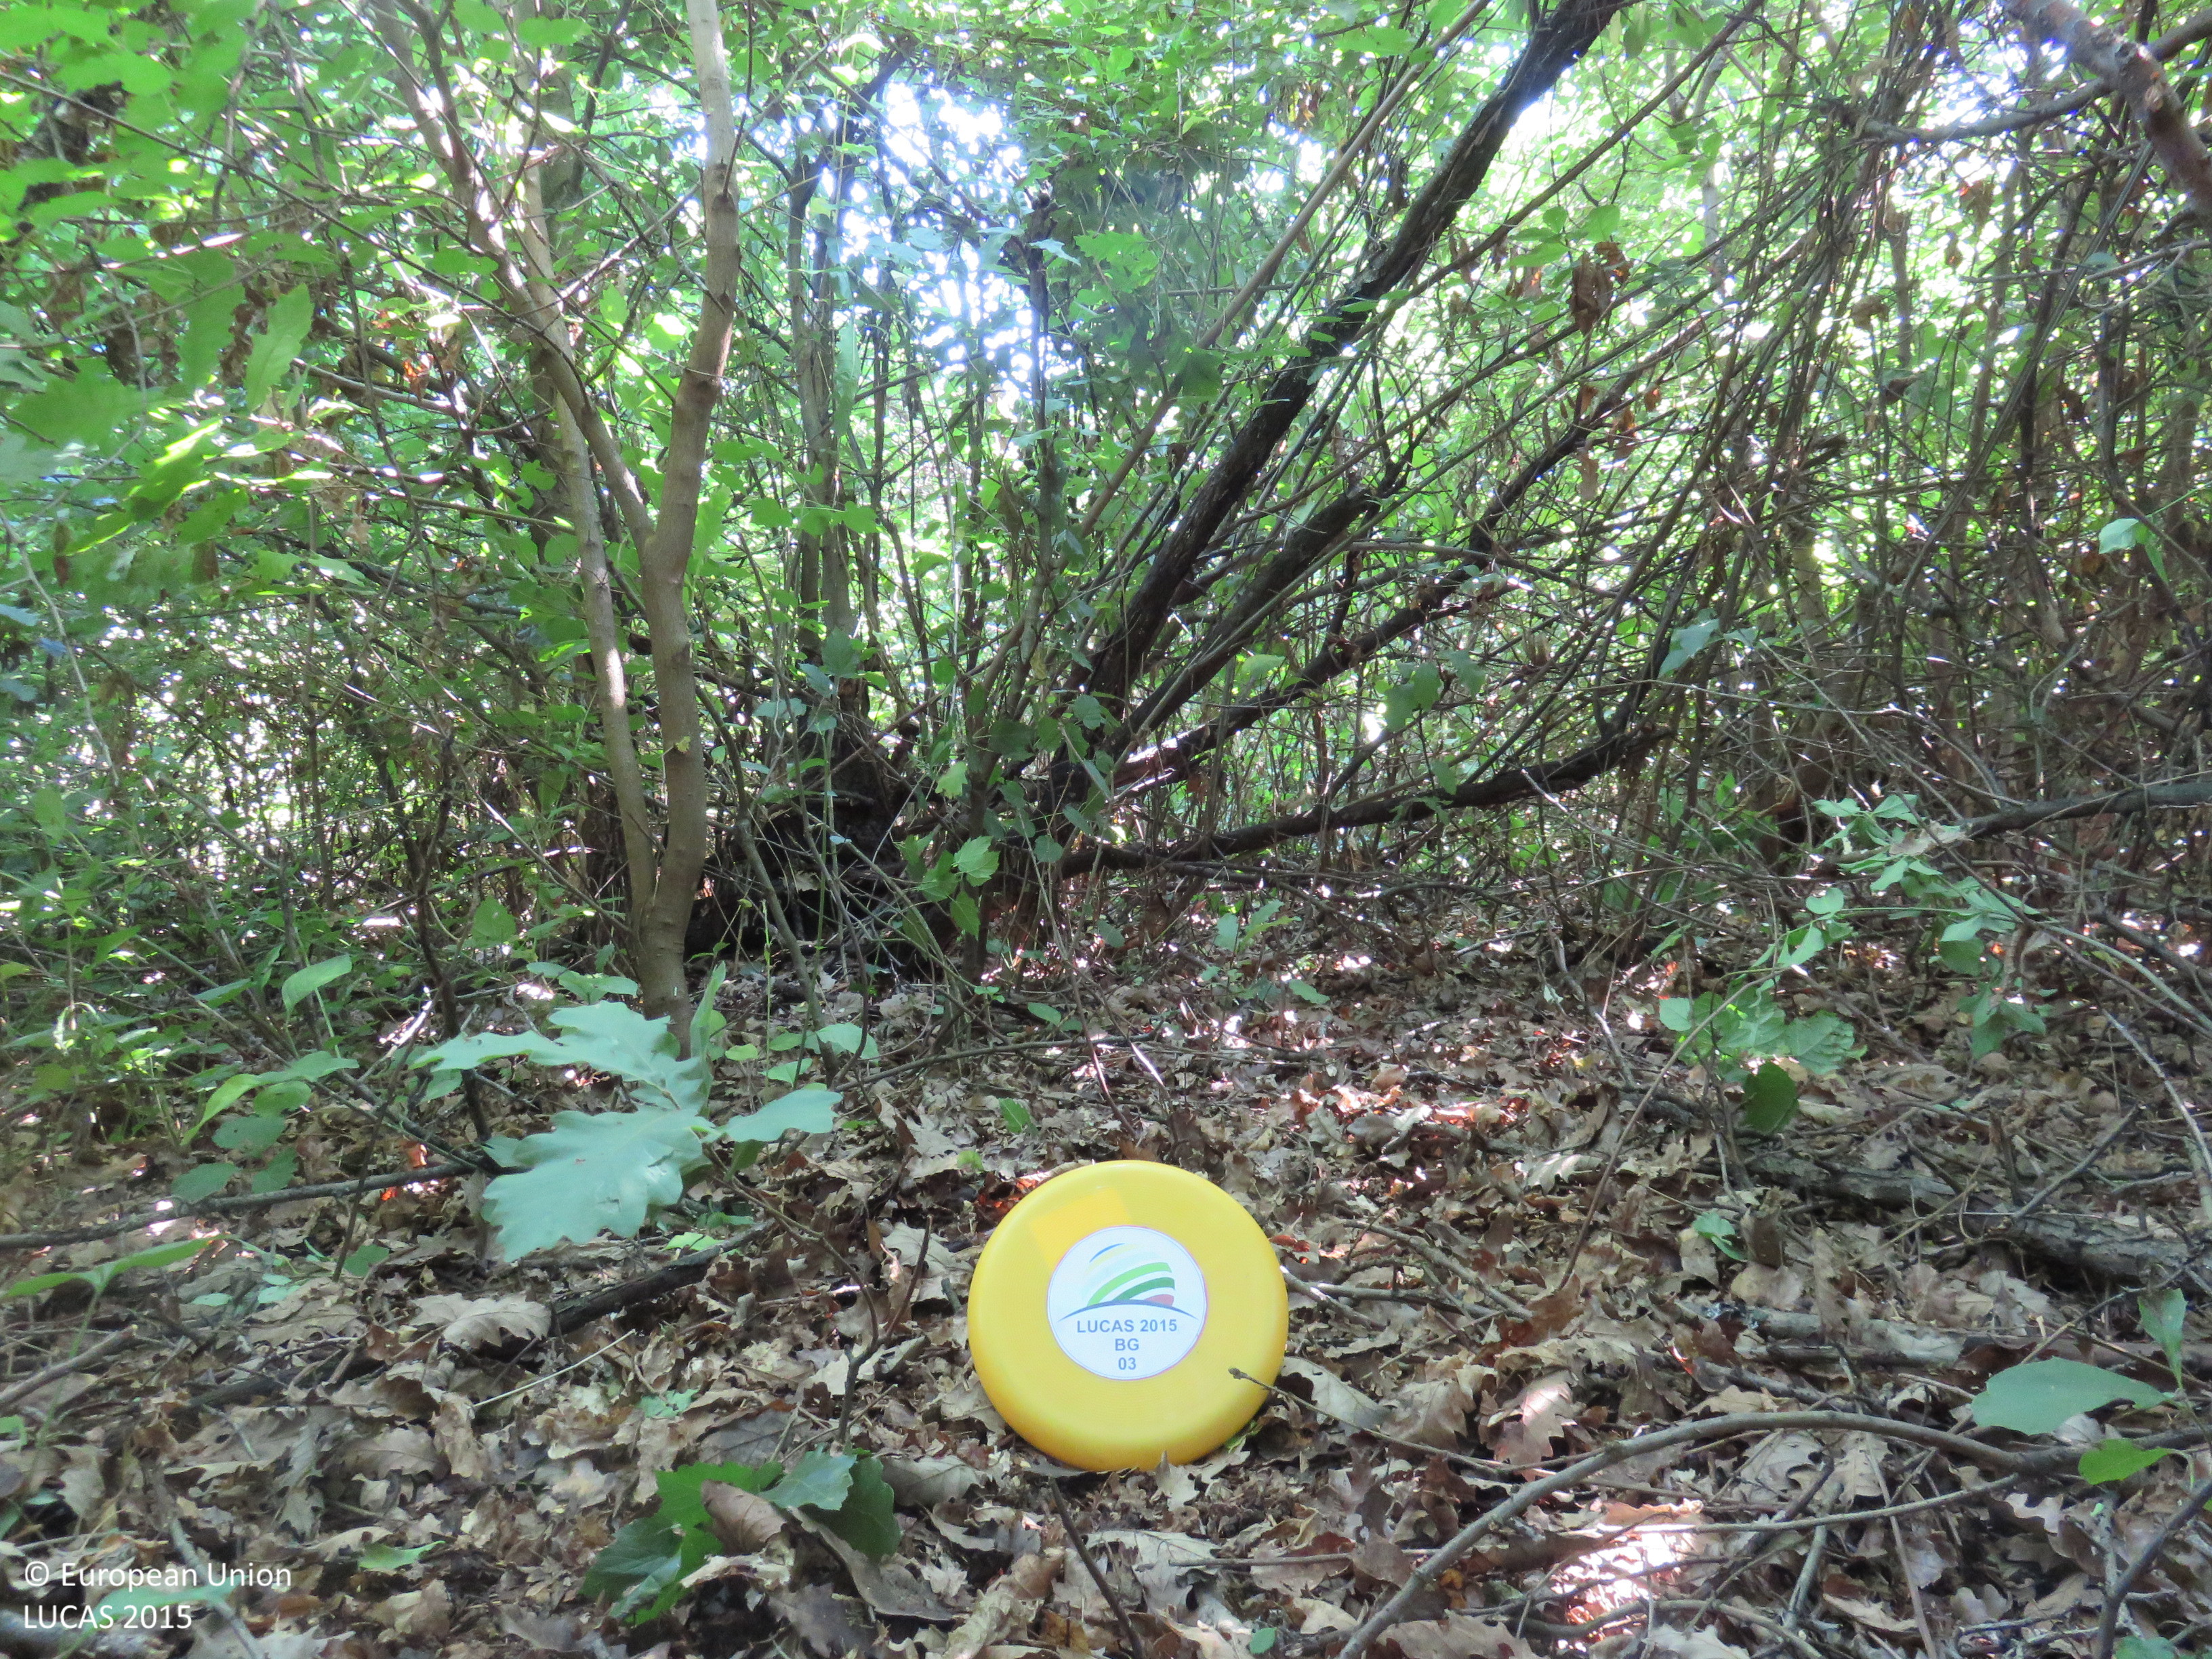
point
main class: Woodland
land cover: Broadleaved woodland
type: mesophytic deciduous forest
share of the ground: > 75 %
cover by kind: broadleaved forest trees 75 %, shrubs 25 %
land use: Semi-natural and natural areas not in use
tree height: < 5 m
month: June
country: BG
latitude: 43.2376
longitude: 24.8551
